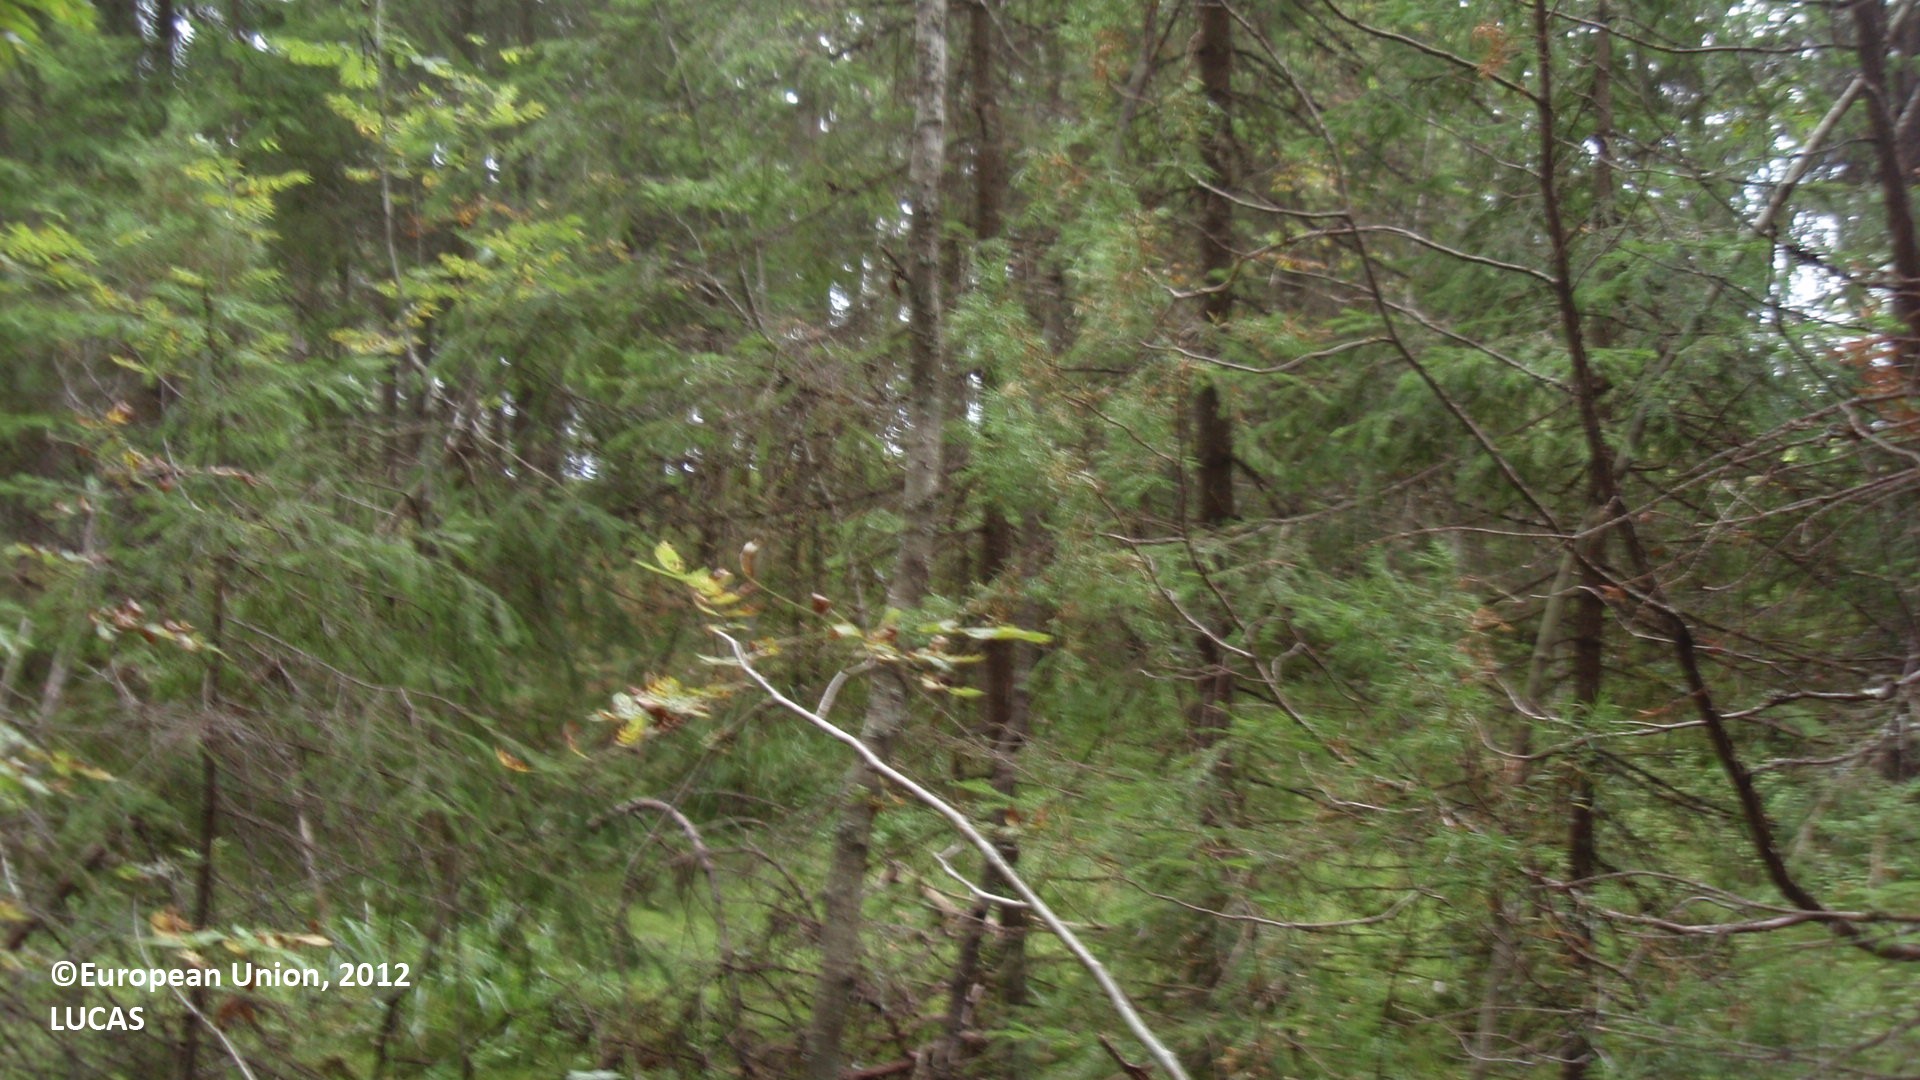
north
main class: Woodland
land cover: Spruce dominated mixed woodland
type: boreal forest
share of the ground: 50 - 75 %
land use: Forestry
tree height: > 5 m
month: August
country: FI
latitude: 60.8375
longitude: 27.4571
